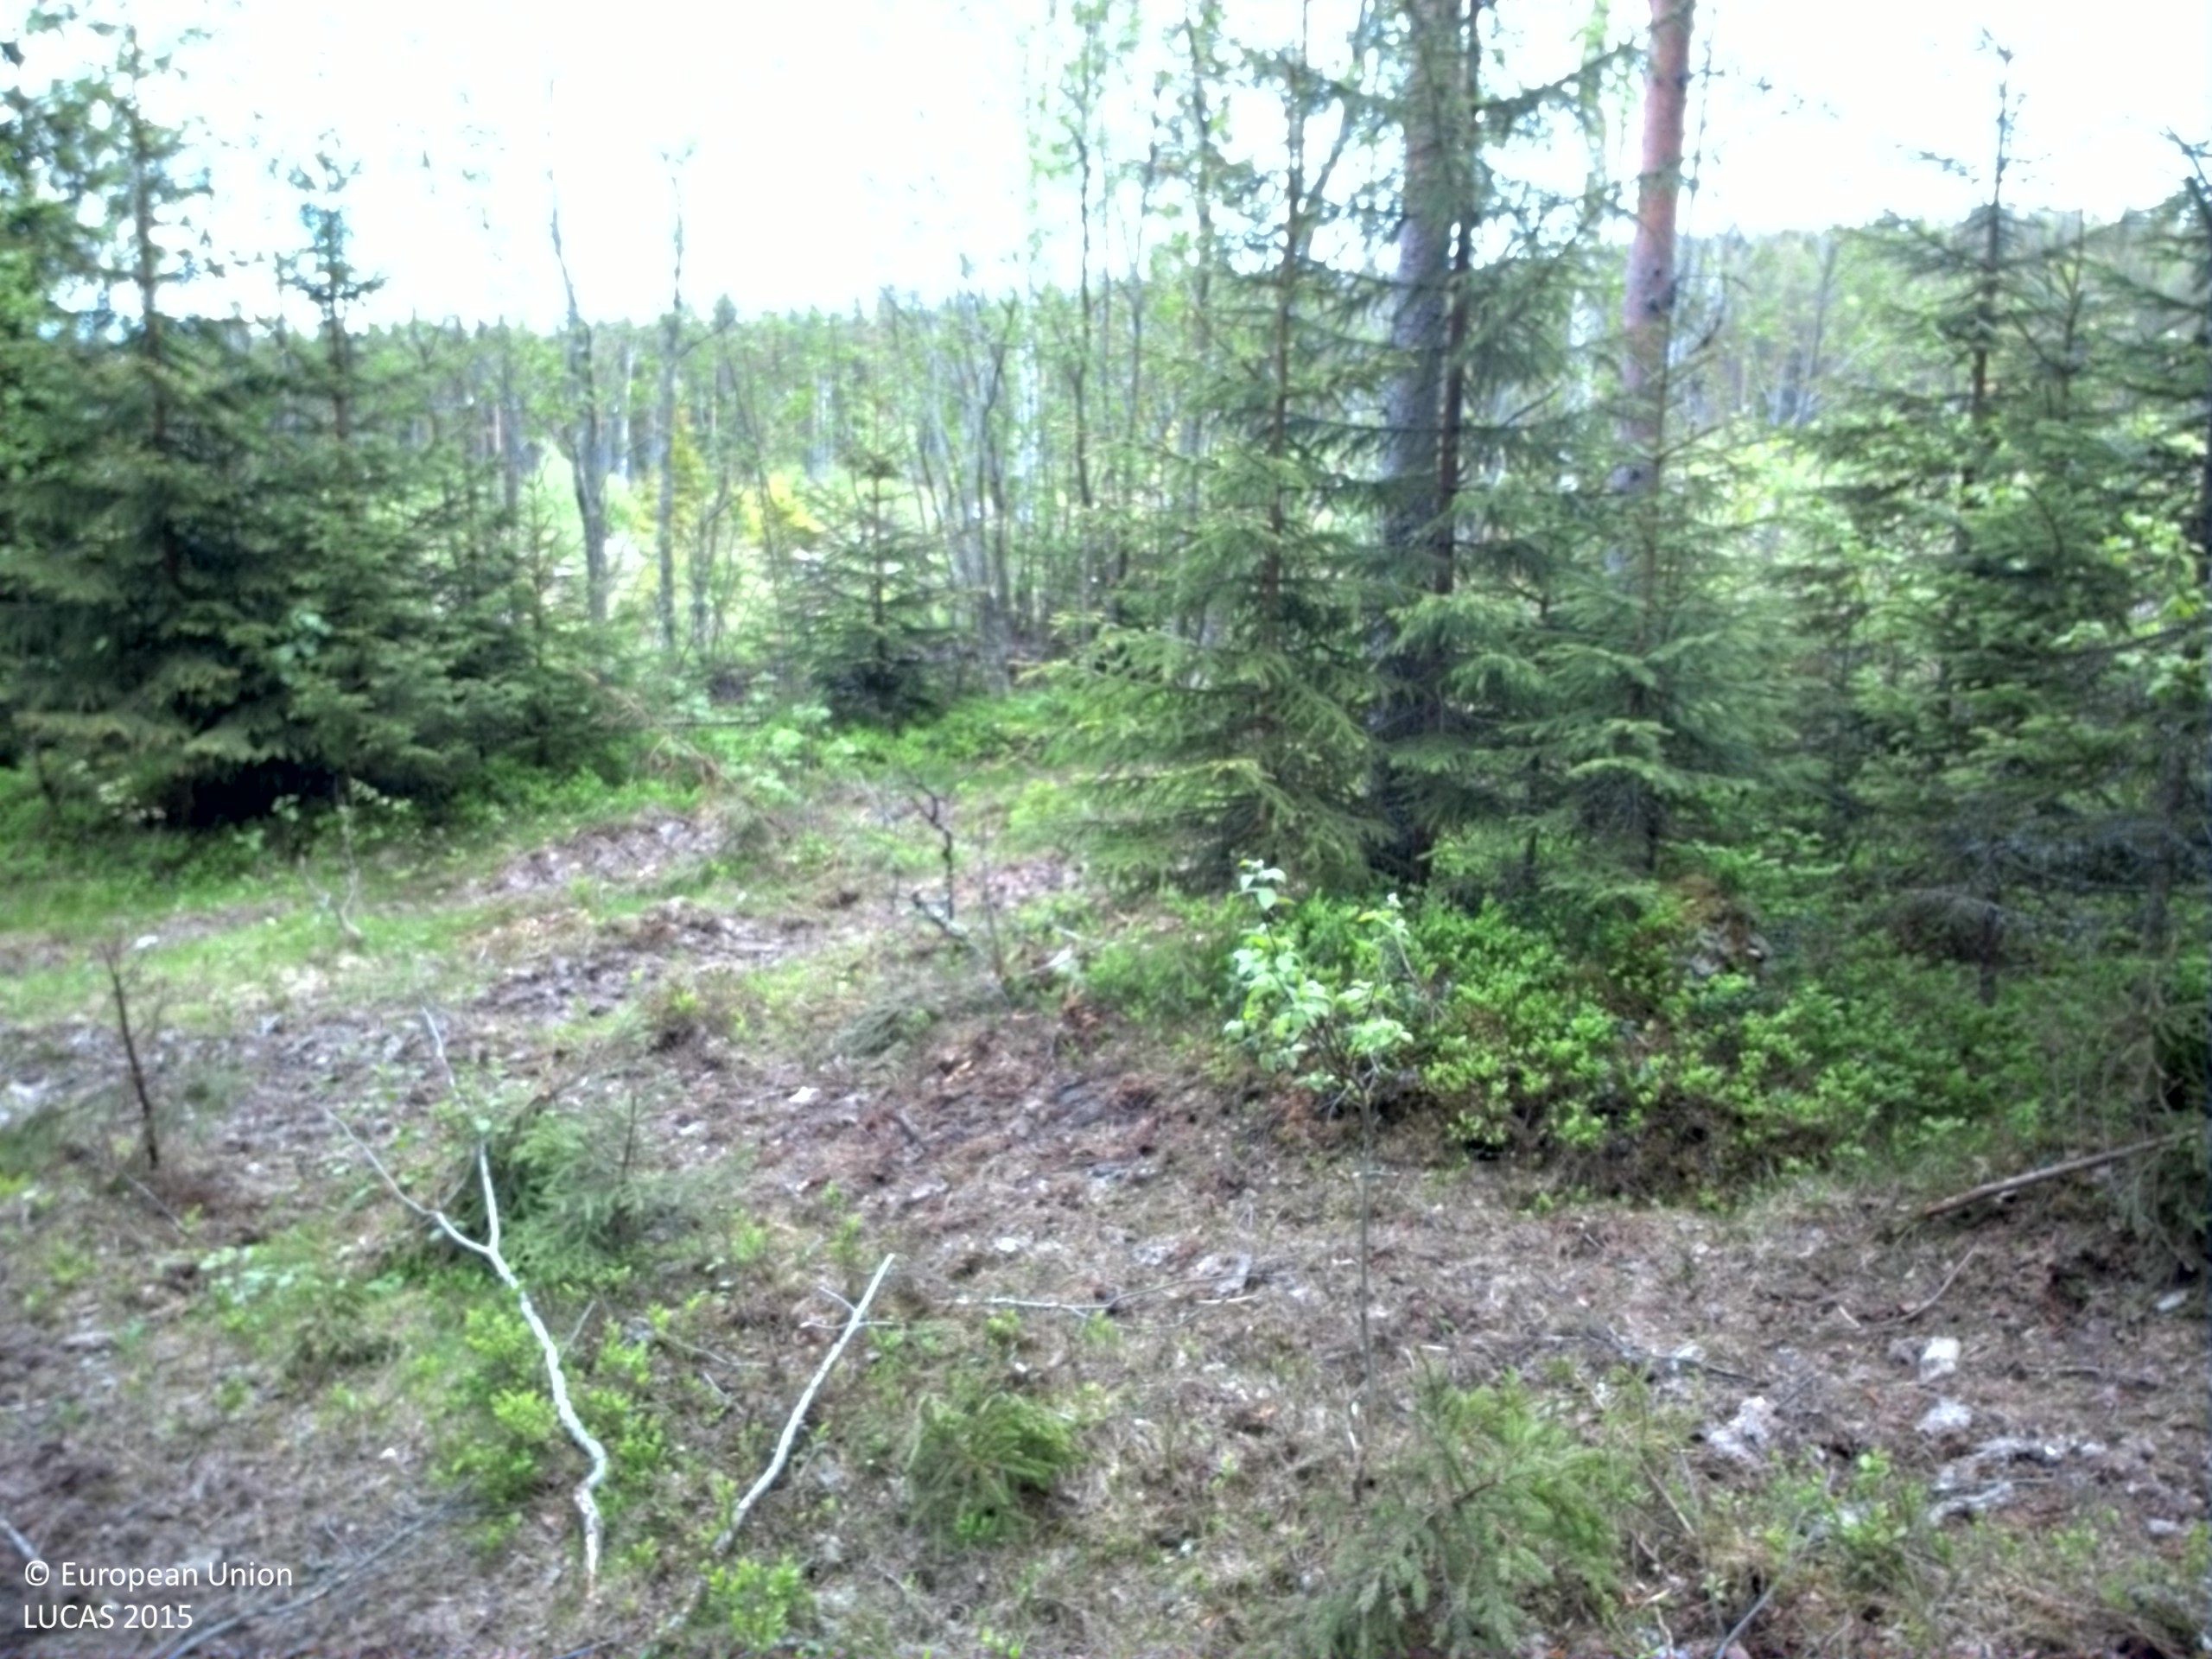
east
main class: Woodland
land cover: Pine dominated coniferous woodland
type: boreal forest
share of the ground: > 75 %
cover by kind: coniferous forest trees 90 %, shrubs 10 %
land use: Forestry
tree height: > 5 m
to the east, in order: Pine dominated coniferous woodland; Tracks; Pine dominated coniferous woodland; Tracks; Broadleaved woodland; Paved roads, cycling and walking lanes; Broadleaved woodland; Pine dominated coniferous woodland
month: June
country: SE
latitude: 63.0402
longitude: 17.1533
